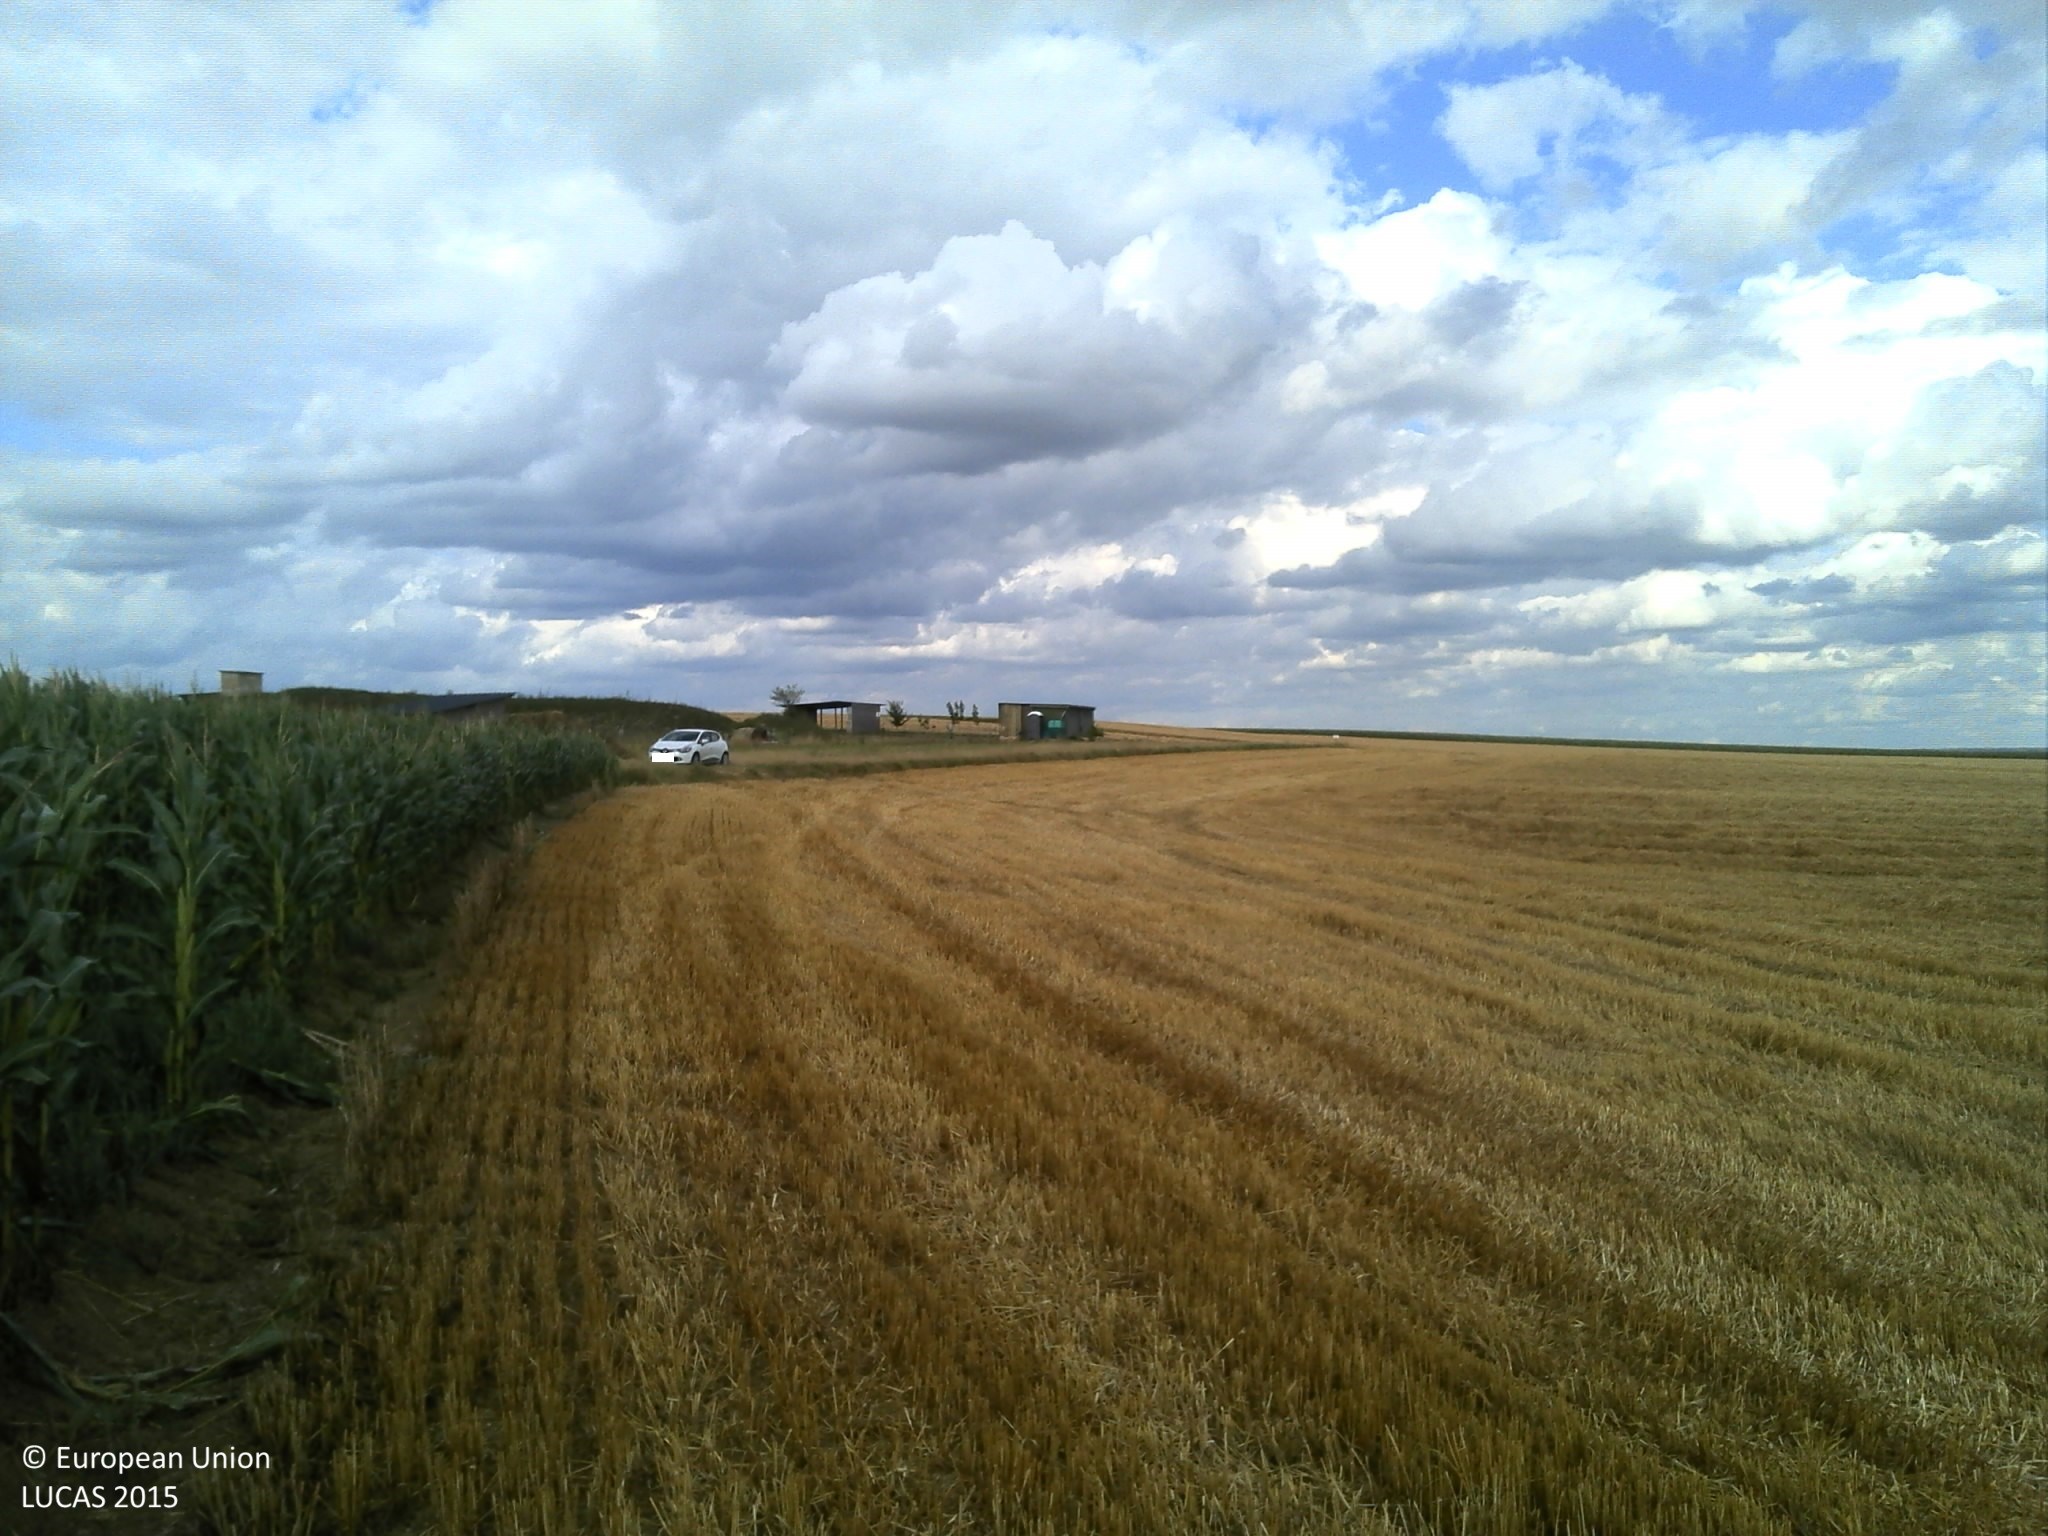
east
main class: Cropland
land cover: Maize
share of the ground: > 75 %
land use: Agriculture (excluding fallow land and kitchen gardens)
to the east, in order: Maize; Tracks; Managed hedges; Grassland without tree/shrub cover; Artificial constructions in urban areas; Grassland without tree/shrub cover; Common wheat
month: July
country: FR
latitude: 49.4755
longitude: 4.5173
